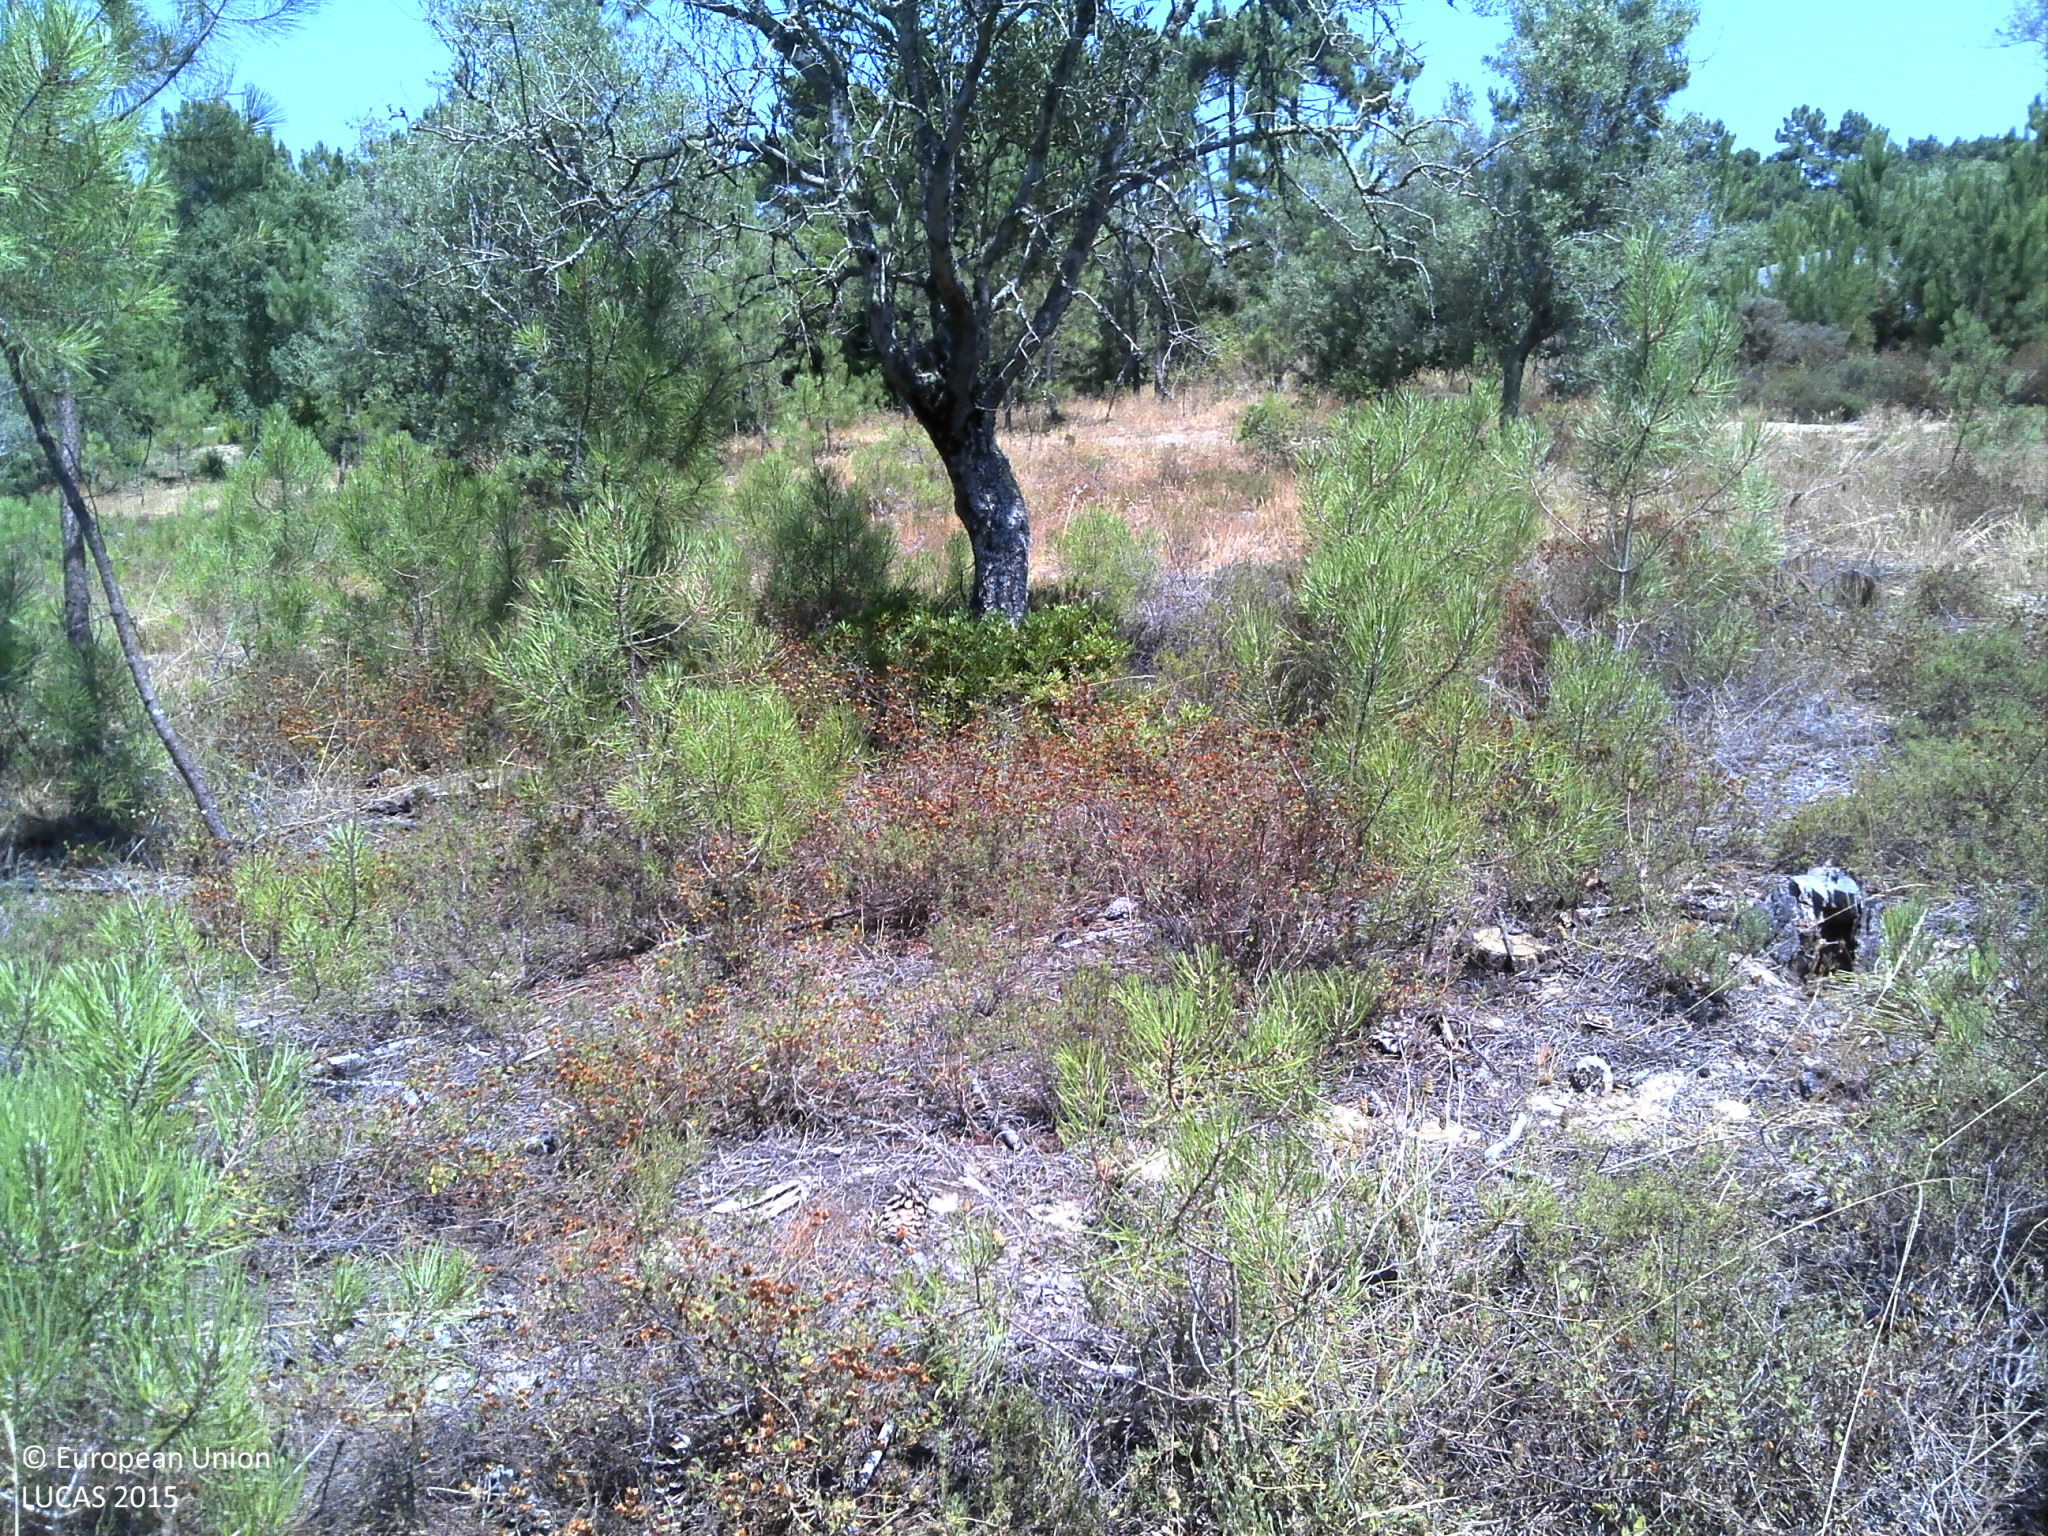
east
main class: Woodland
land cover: Pine dominated coniferous woodland
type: coniferous forest of the mediterranean region
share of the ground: 25 - 50 %
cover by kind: coniferous forest trees 35 %, unconsolidated bare surface 30 %, shrubs 15 %, herbaceous plants 15 %, broadleaved forest trees 5 %
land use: Forestry
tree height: > 5 m
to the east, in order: Pine dominated coniferous woodland; Tracks; Electric lines; Broadleaved woodland; Pine dominated coniferous woodland; Tracks; Electric lines; Artificial constructions; Other bare soil; Artificial constructions; Single bushes/trees; Paved roads, cycling and walking lanes; Grassland with sparse tree/shrub cover; Other bare soil; Paved roads, cycling and walking lanes
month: June
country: PT
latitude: 38.4892
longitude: -9.0652
